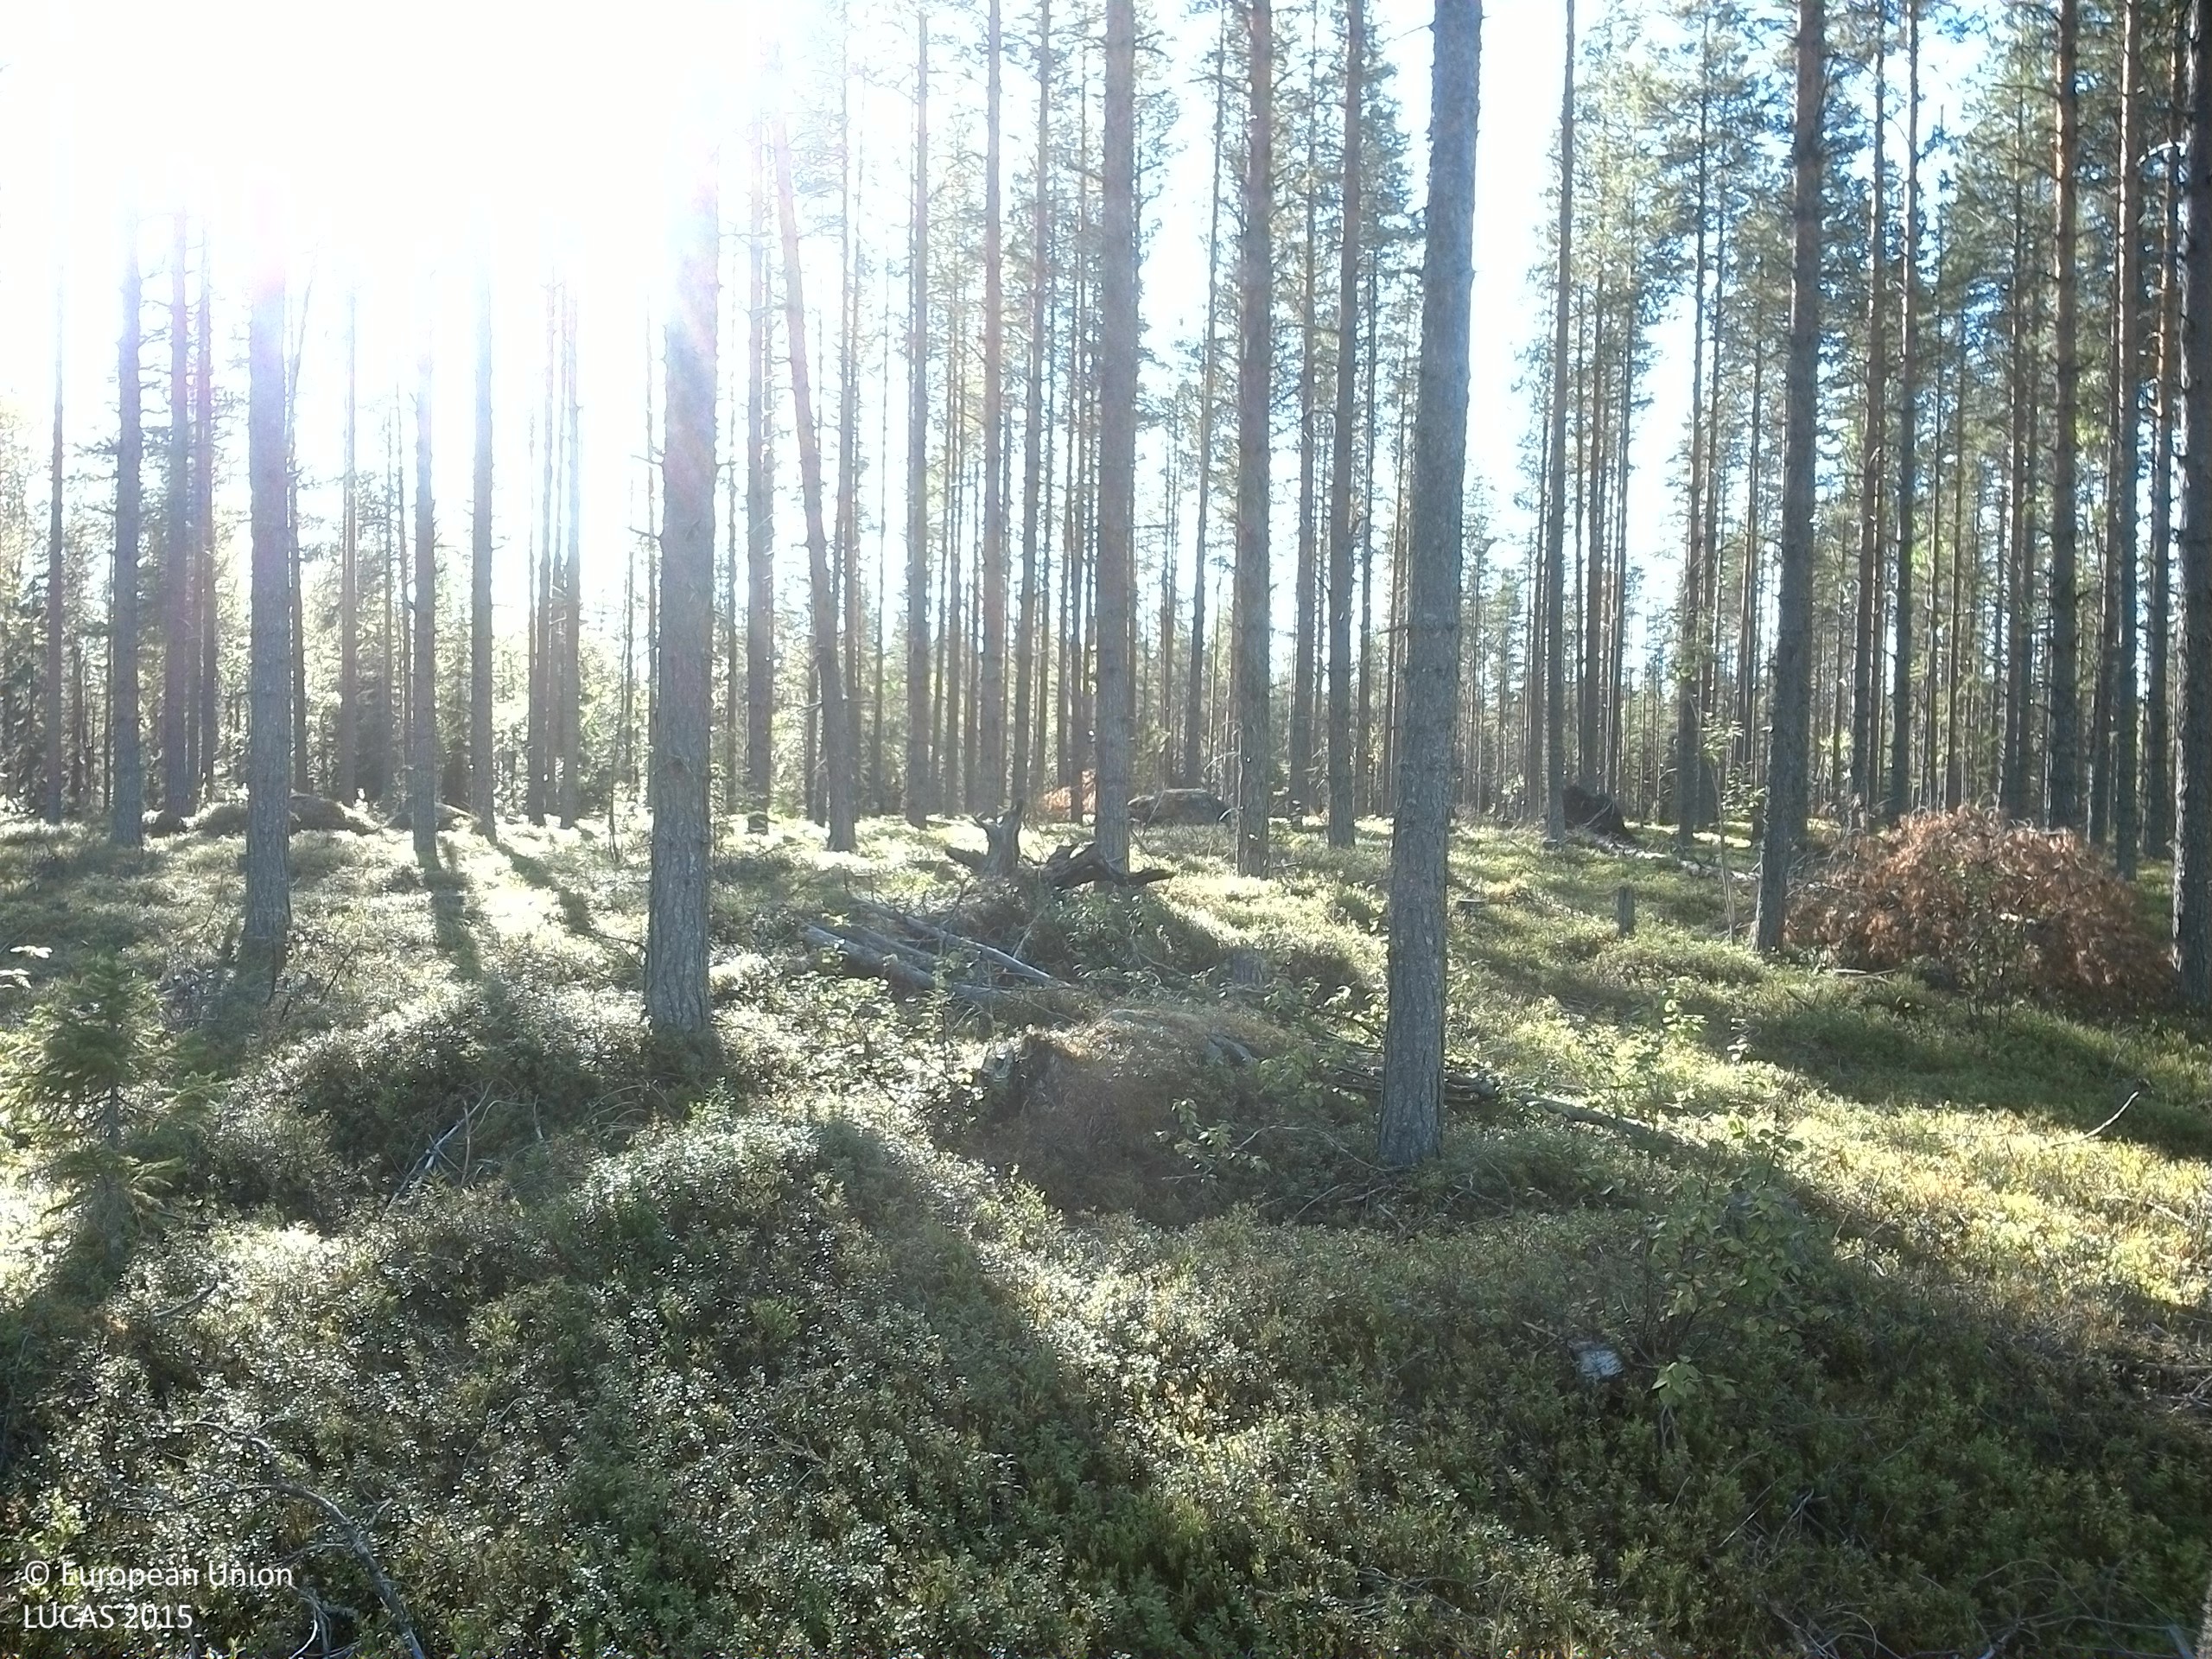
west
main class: Woodland
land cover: Pine dominated coniferous woodland
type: boreal forest
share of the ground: 50 - 75 %
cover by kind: coniferous forest trees 55 %, shrubs 45 %
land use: Forestry
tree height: > 5 m
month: August
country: SE
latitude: 63.8908
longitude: 17.5681
